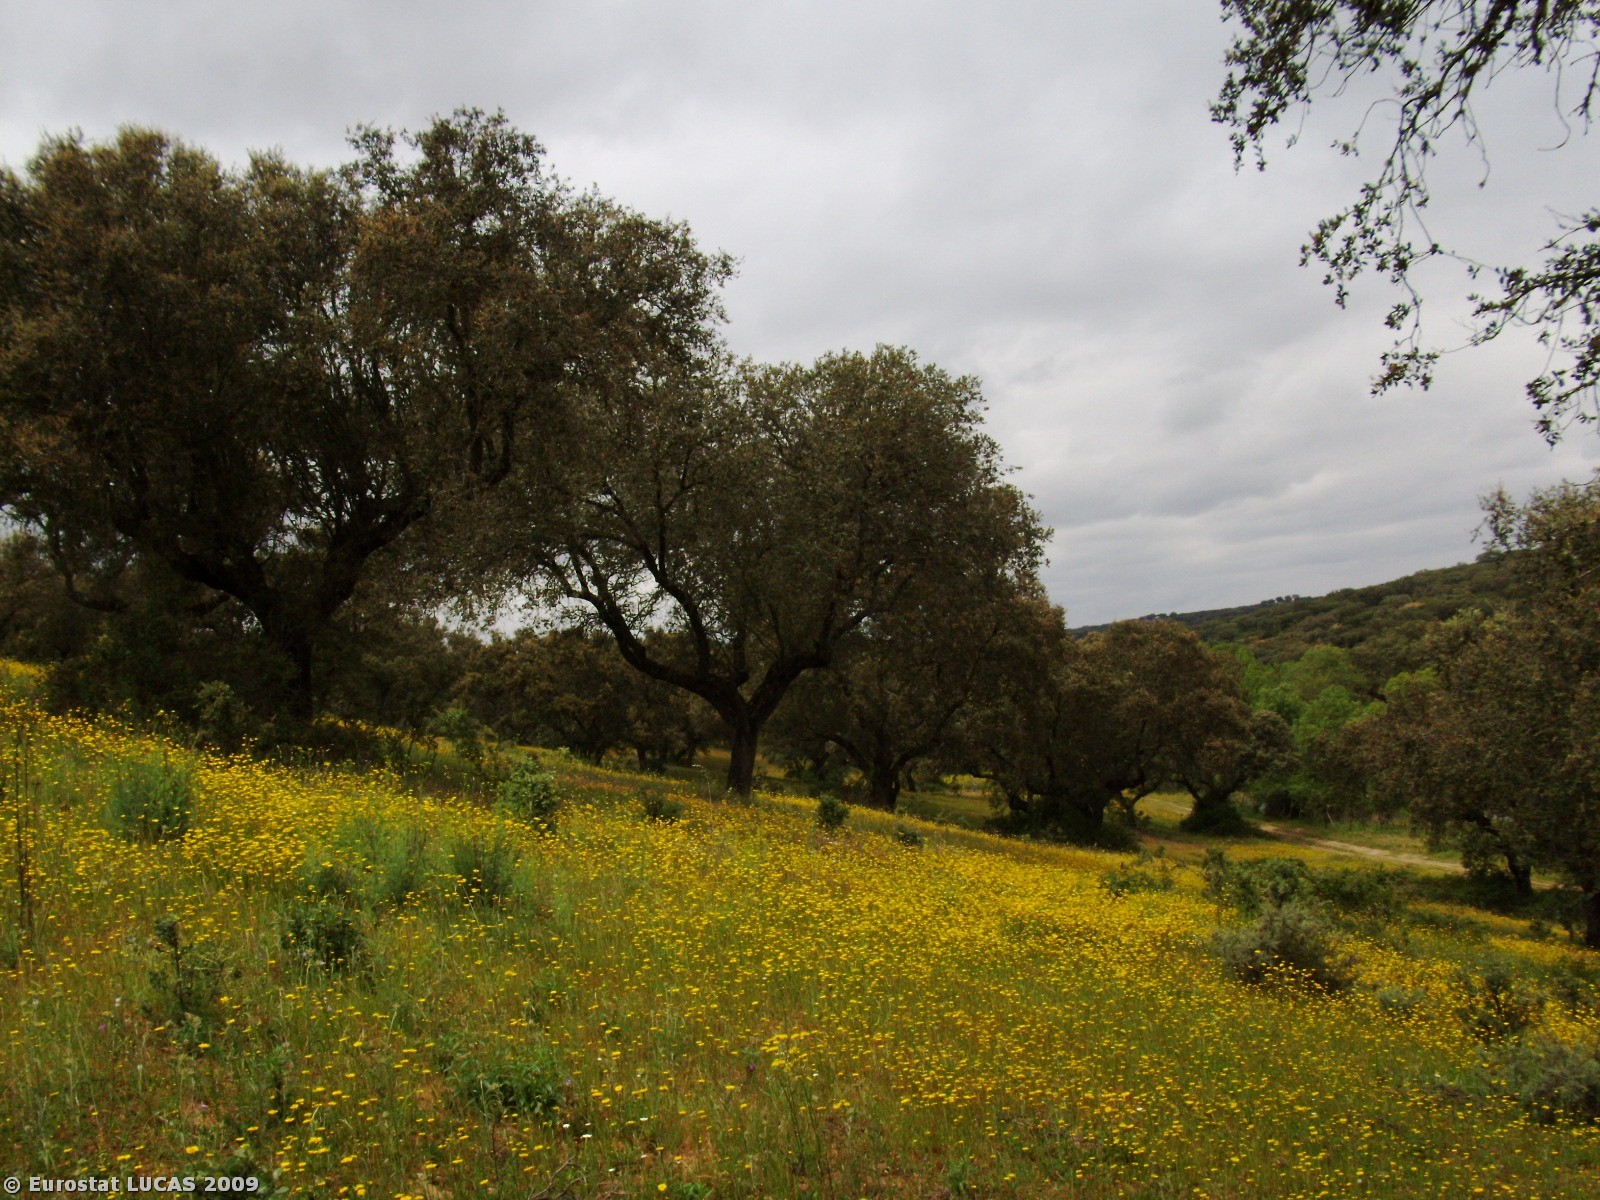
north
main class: Woodland
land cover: Broadleaved woodland
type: broadleaved evergreen forest
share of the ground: 10 - 25 %
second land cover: Spontaneously vegetated surfaces
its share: > 75 %
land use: Forestry
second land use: Fallow land
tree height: > 5 m
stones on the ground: 25 - 50 %
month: April
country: PT
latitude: 38.4953
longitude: -7.7017
